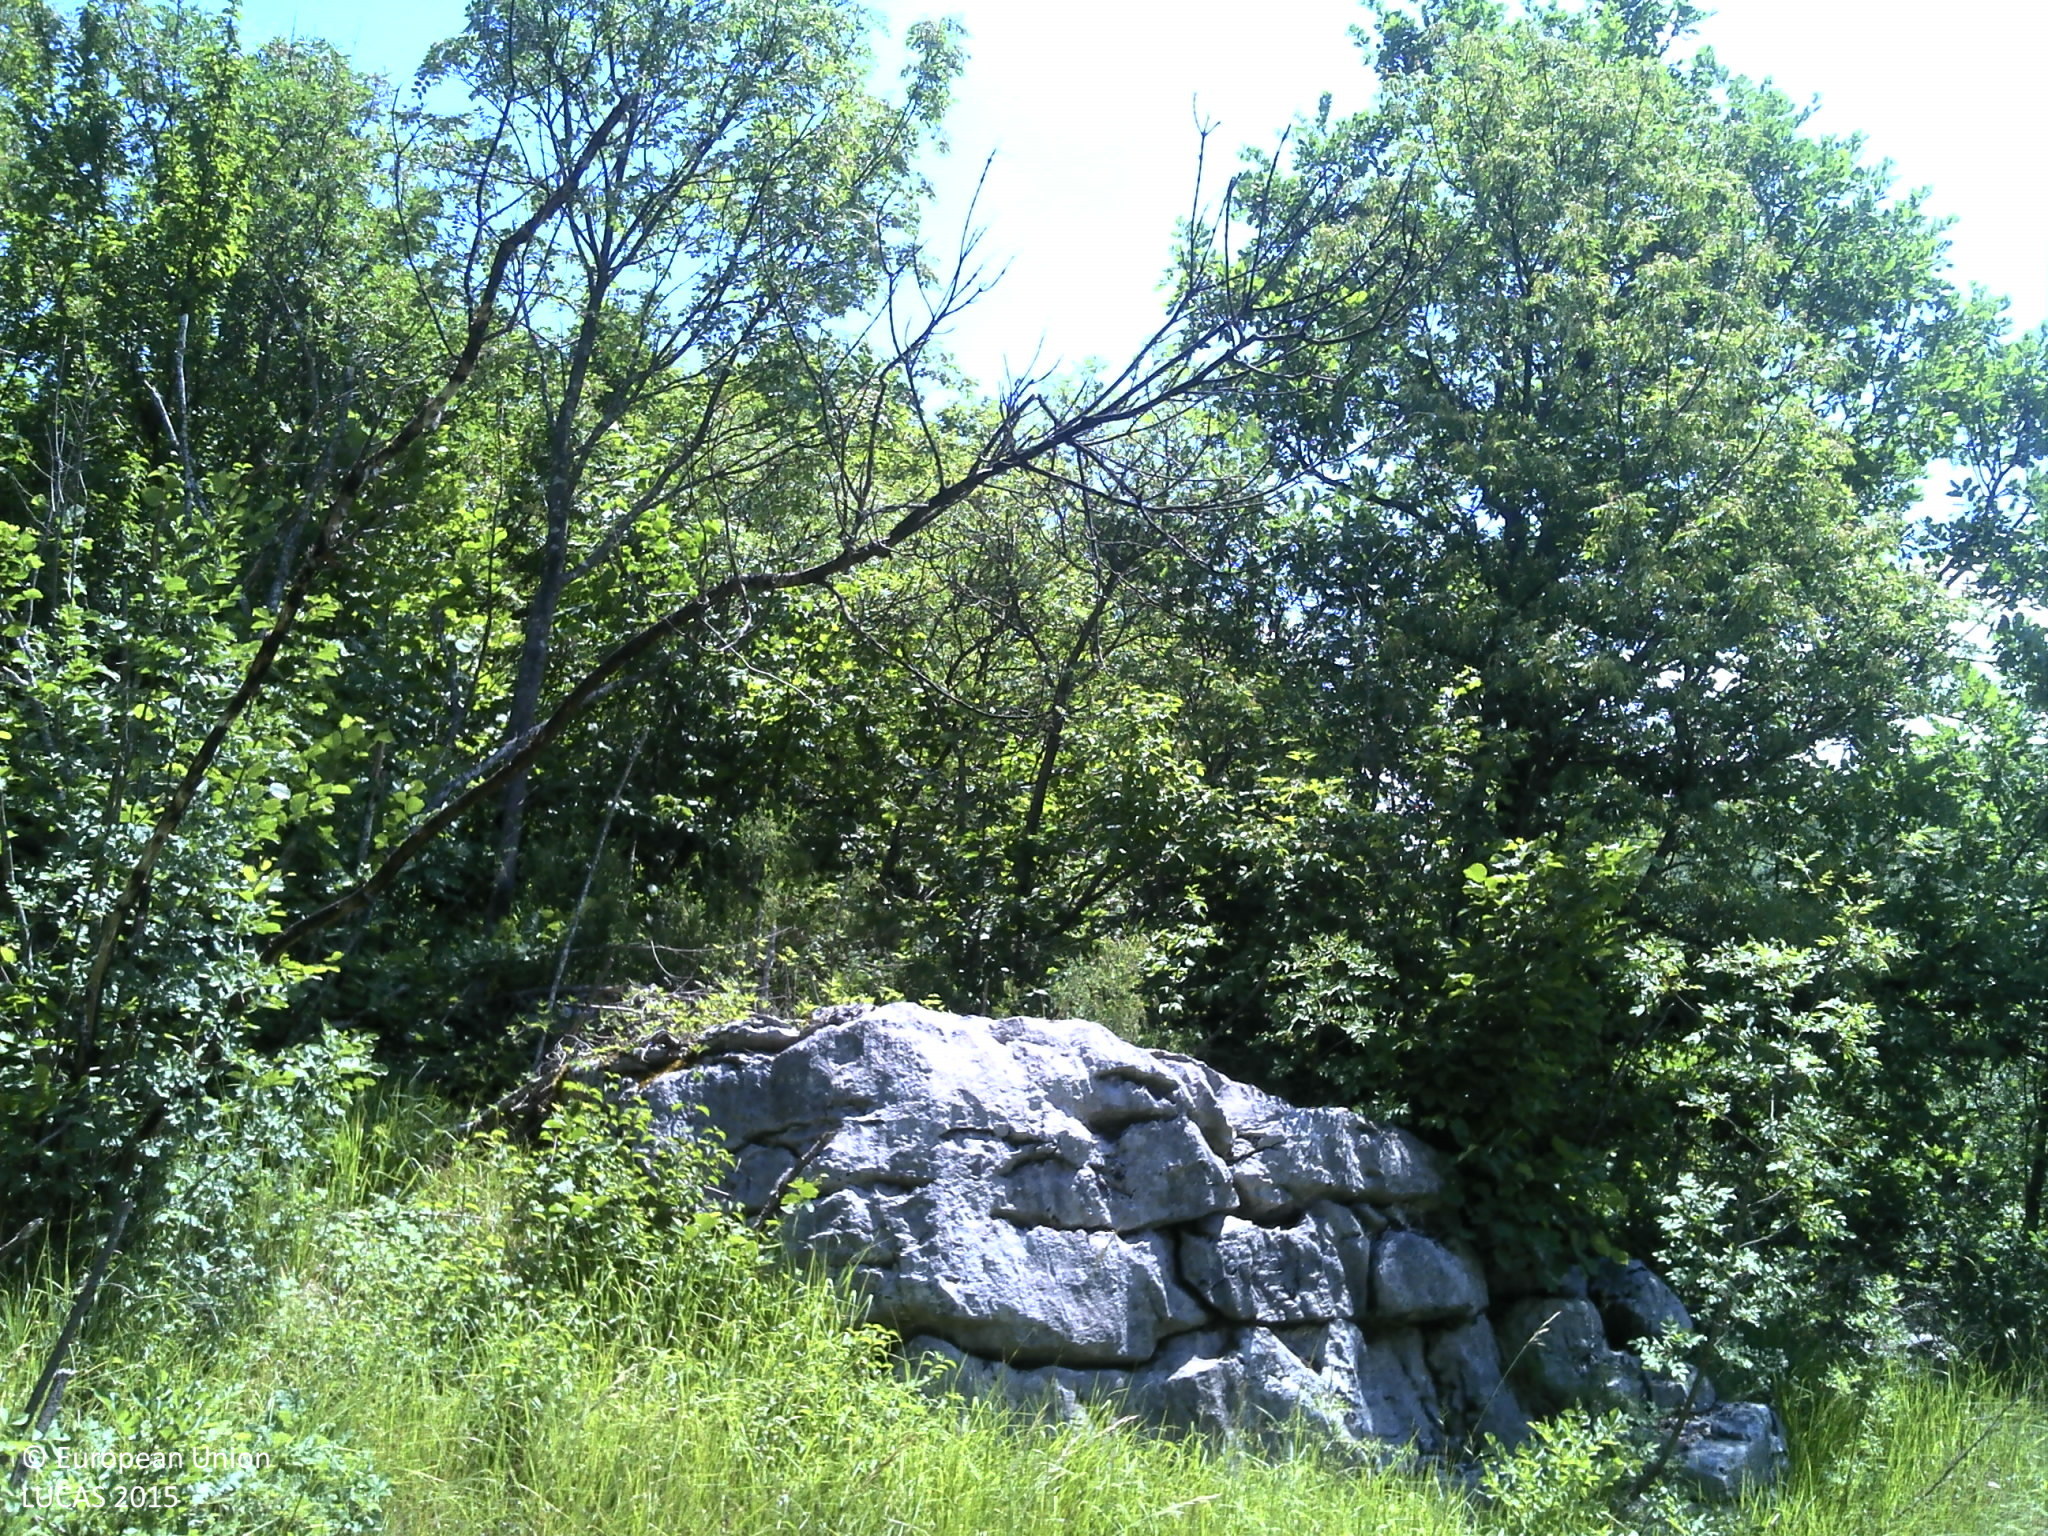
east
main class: Woodland
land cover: Broadleaved woodland
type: thermophilous deciduous forest
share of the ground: > 75 %
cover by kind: broadleaved forest trees 75 %, herbaceous plants 20 %, consolidated bare surface 5 %
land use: Semi-natural and natural areas not in use
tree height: > 5 m
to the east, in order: Broadleaved woodland
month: June
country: HR
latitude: 44.4379
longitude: 15.5337
